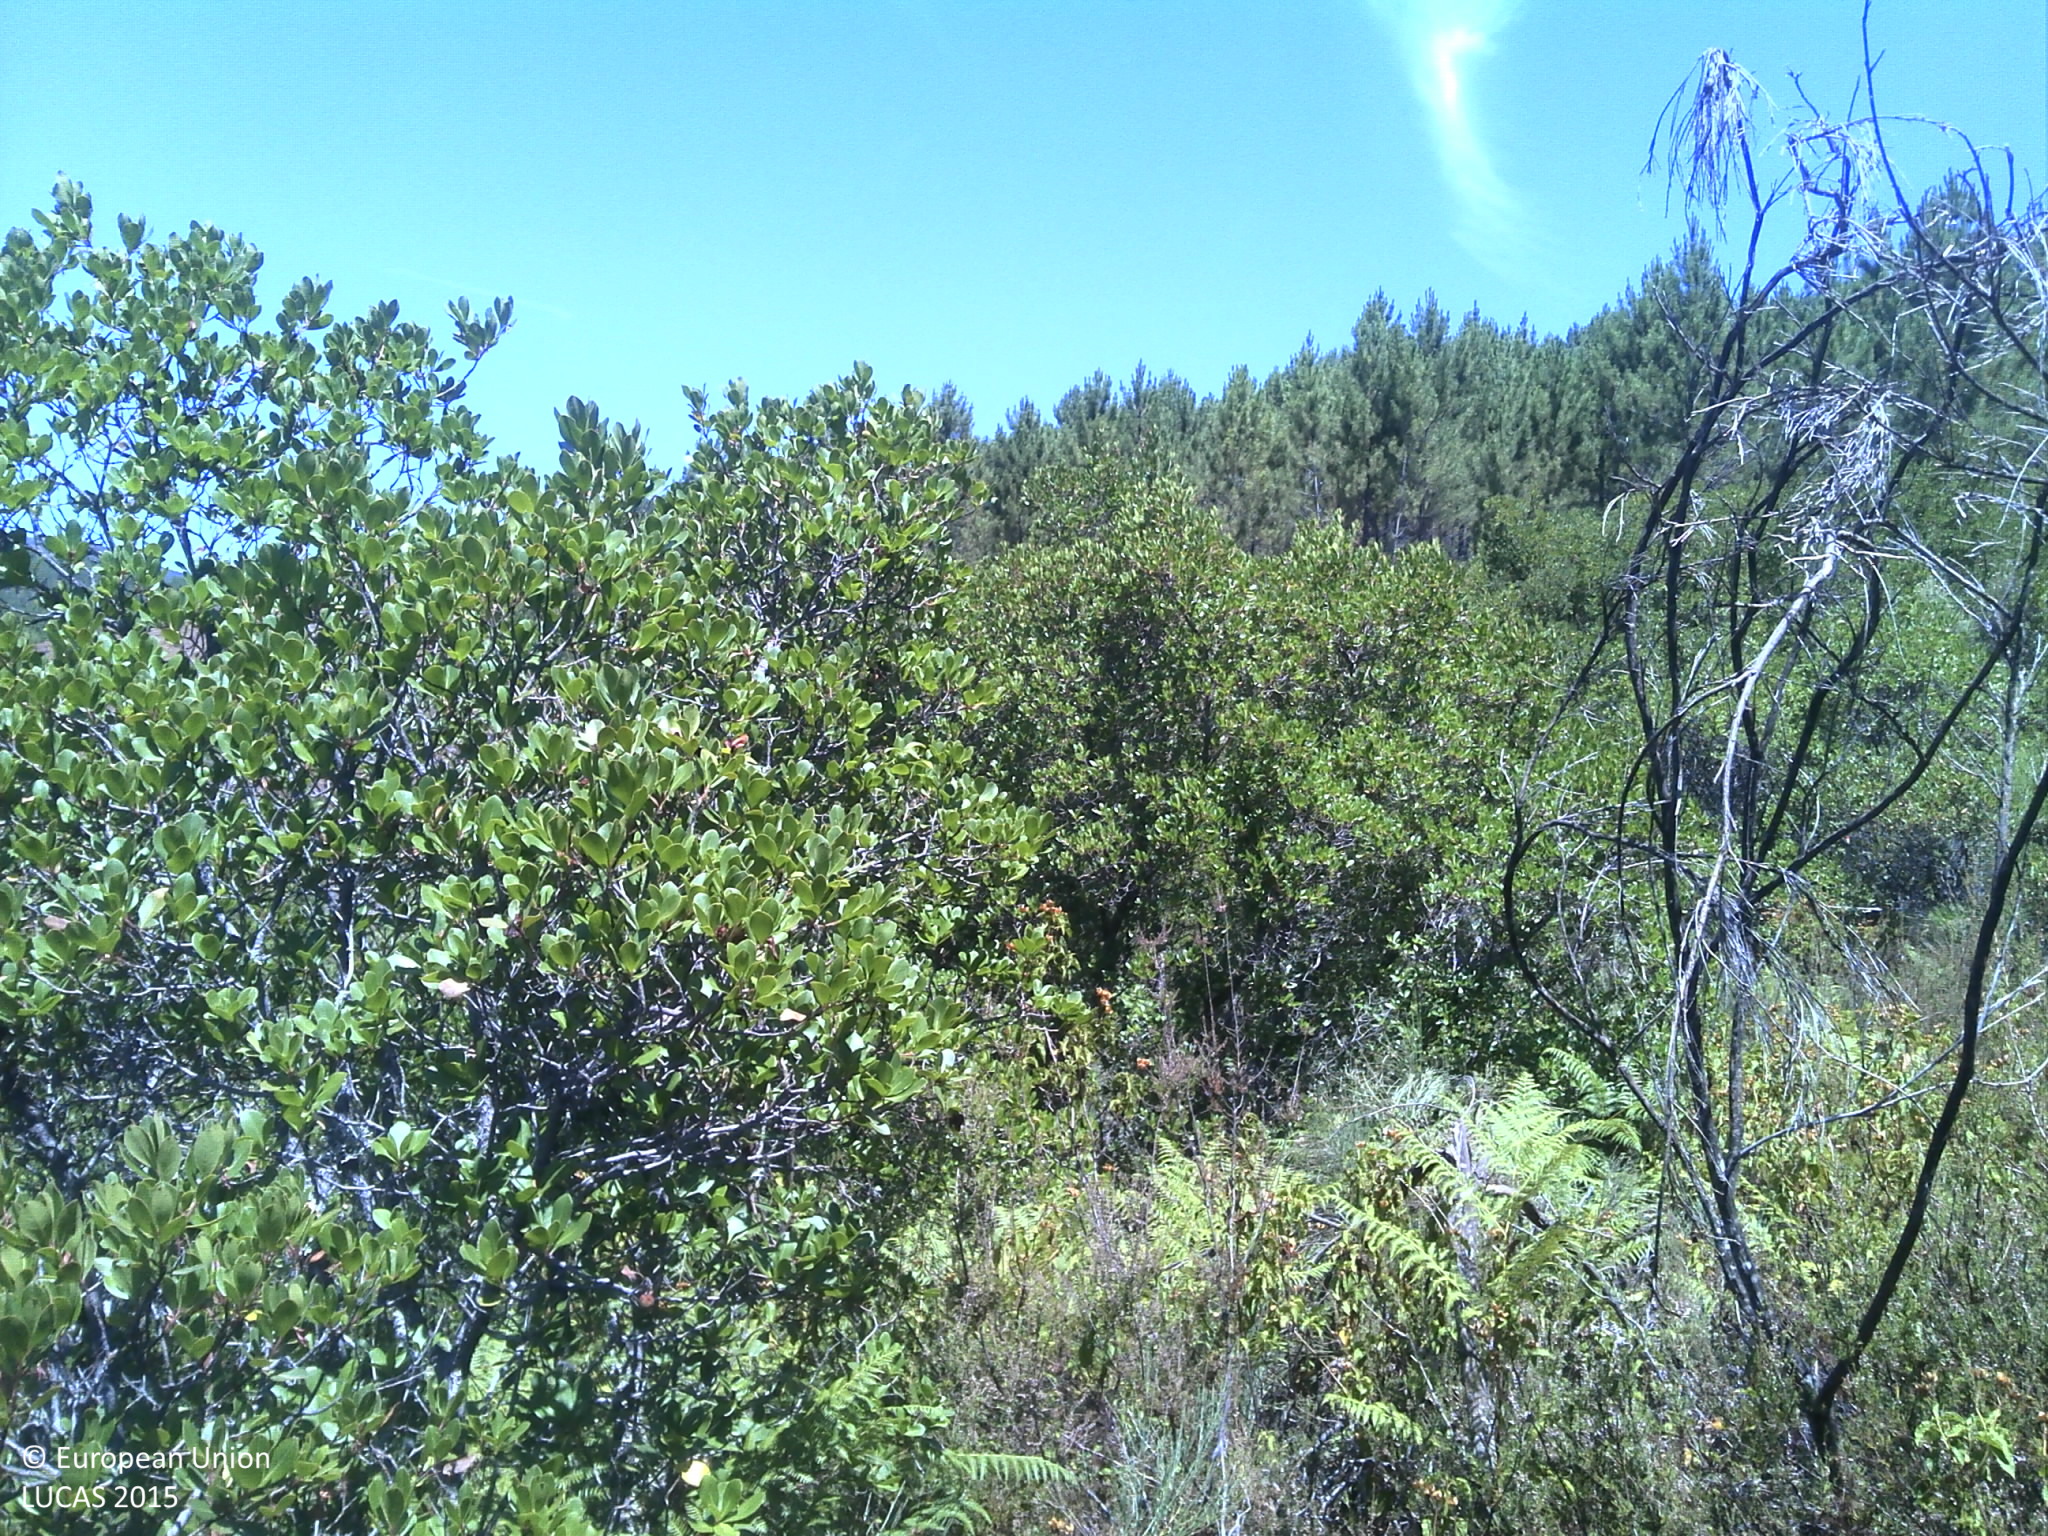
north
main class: Shrubland
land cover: Shrubland without tree cover
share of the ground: 50 - 75 %
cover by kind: shrubs 70 %, herbaceous plants 10 %, unconsolidated bare surface 10 %
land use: Forestry
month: July
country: PT
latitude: 40.1870
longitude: -7.7415
